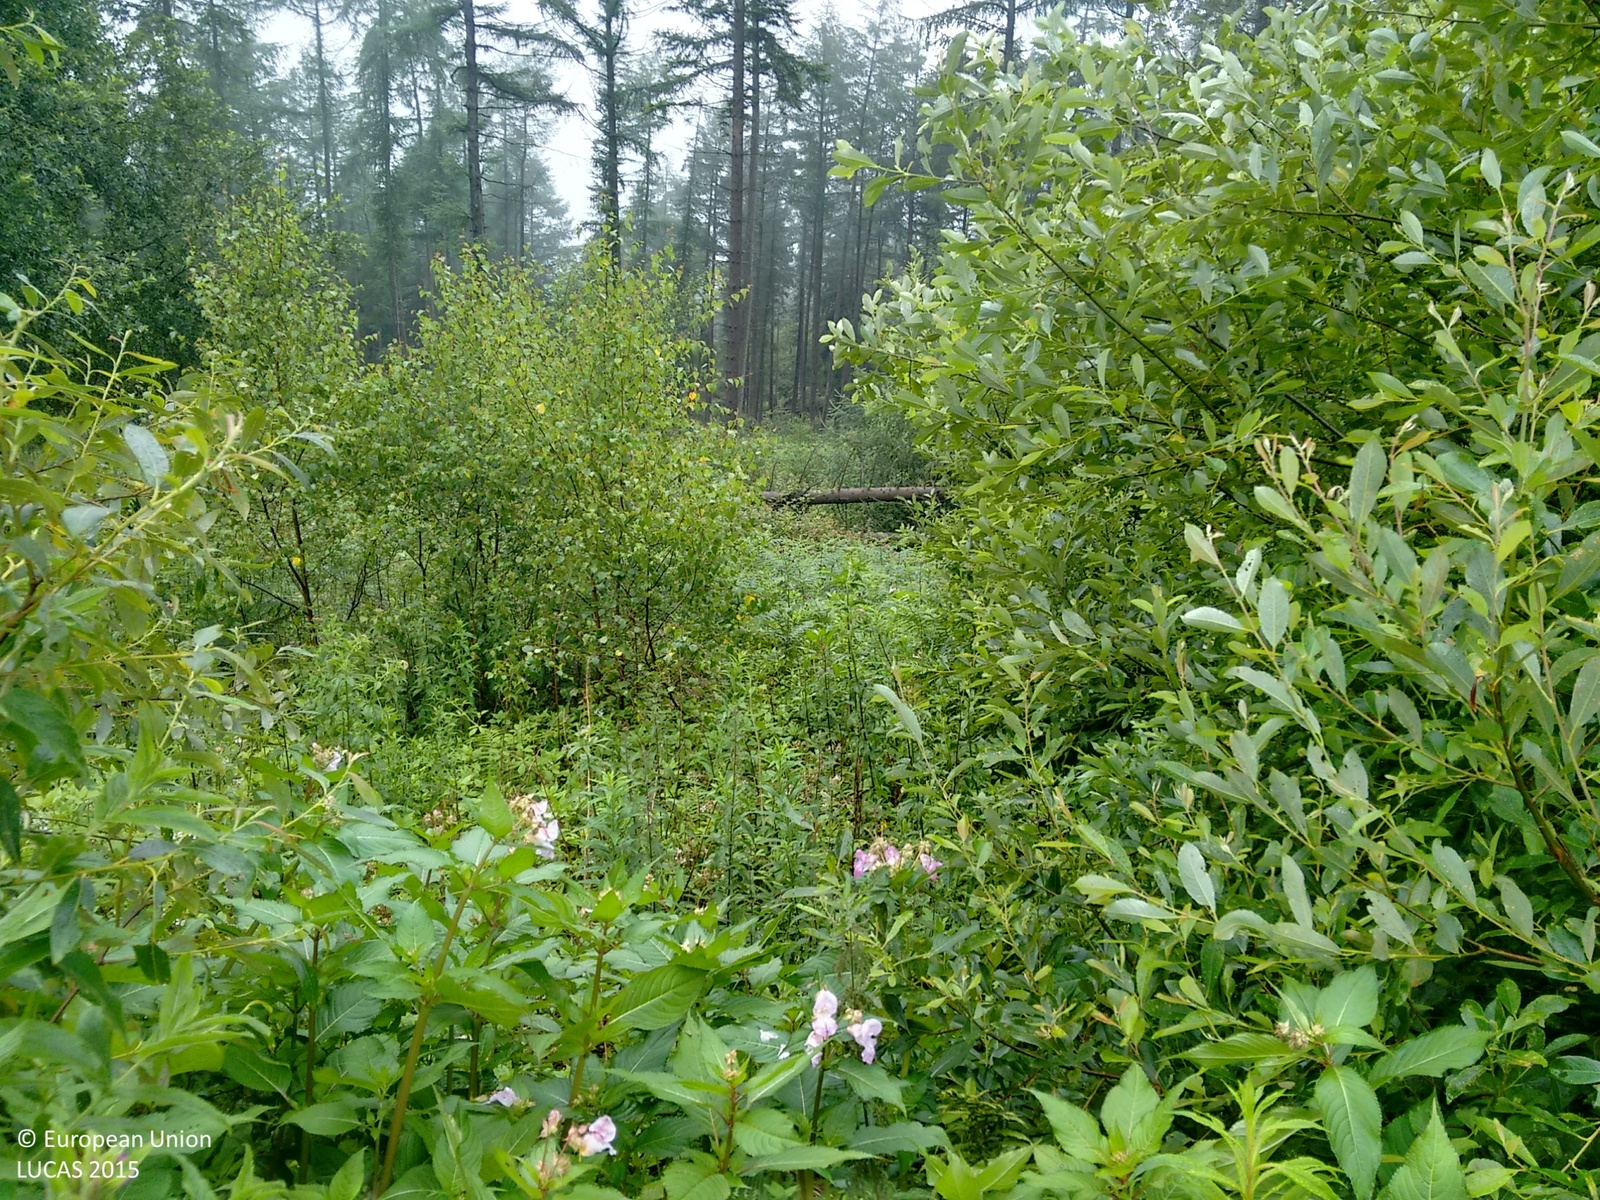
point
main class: Shrubland
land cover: Shrubland with sparse tree cover
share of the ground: > 75 %
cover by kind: shrubs 75 %, herbaceous plants 20 %, coniferous forest trees 5 %
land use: Forestry
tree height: > 5 m
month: July
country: GB
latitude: 51.7195
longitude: -3.7395
